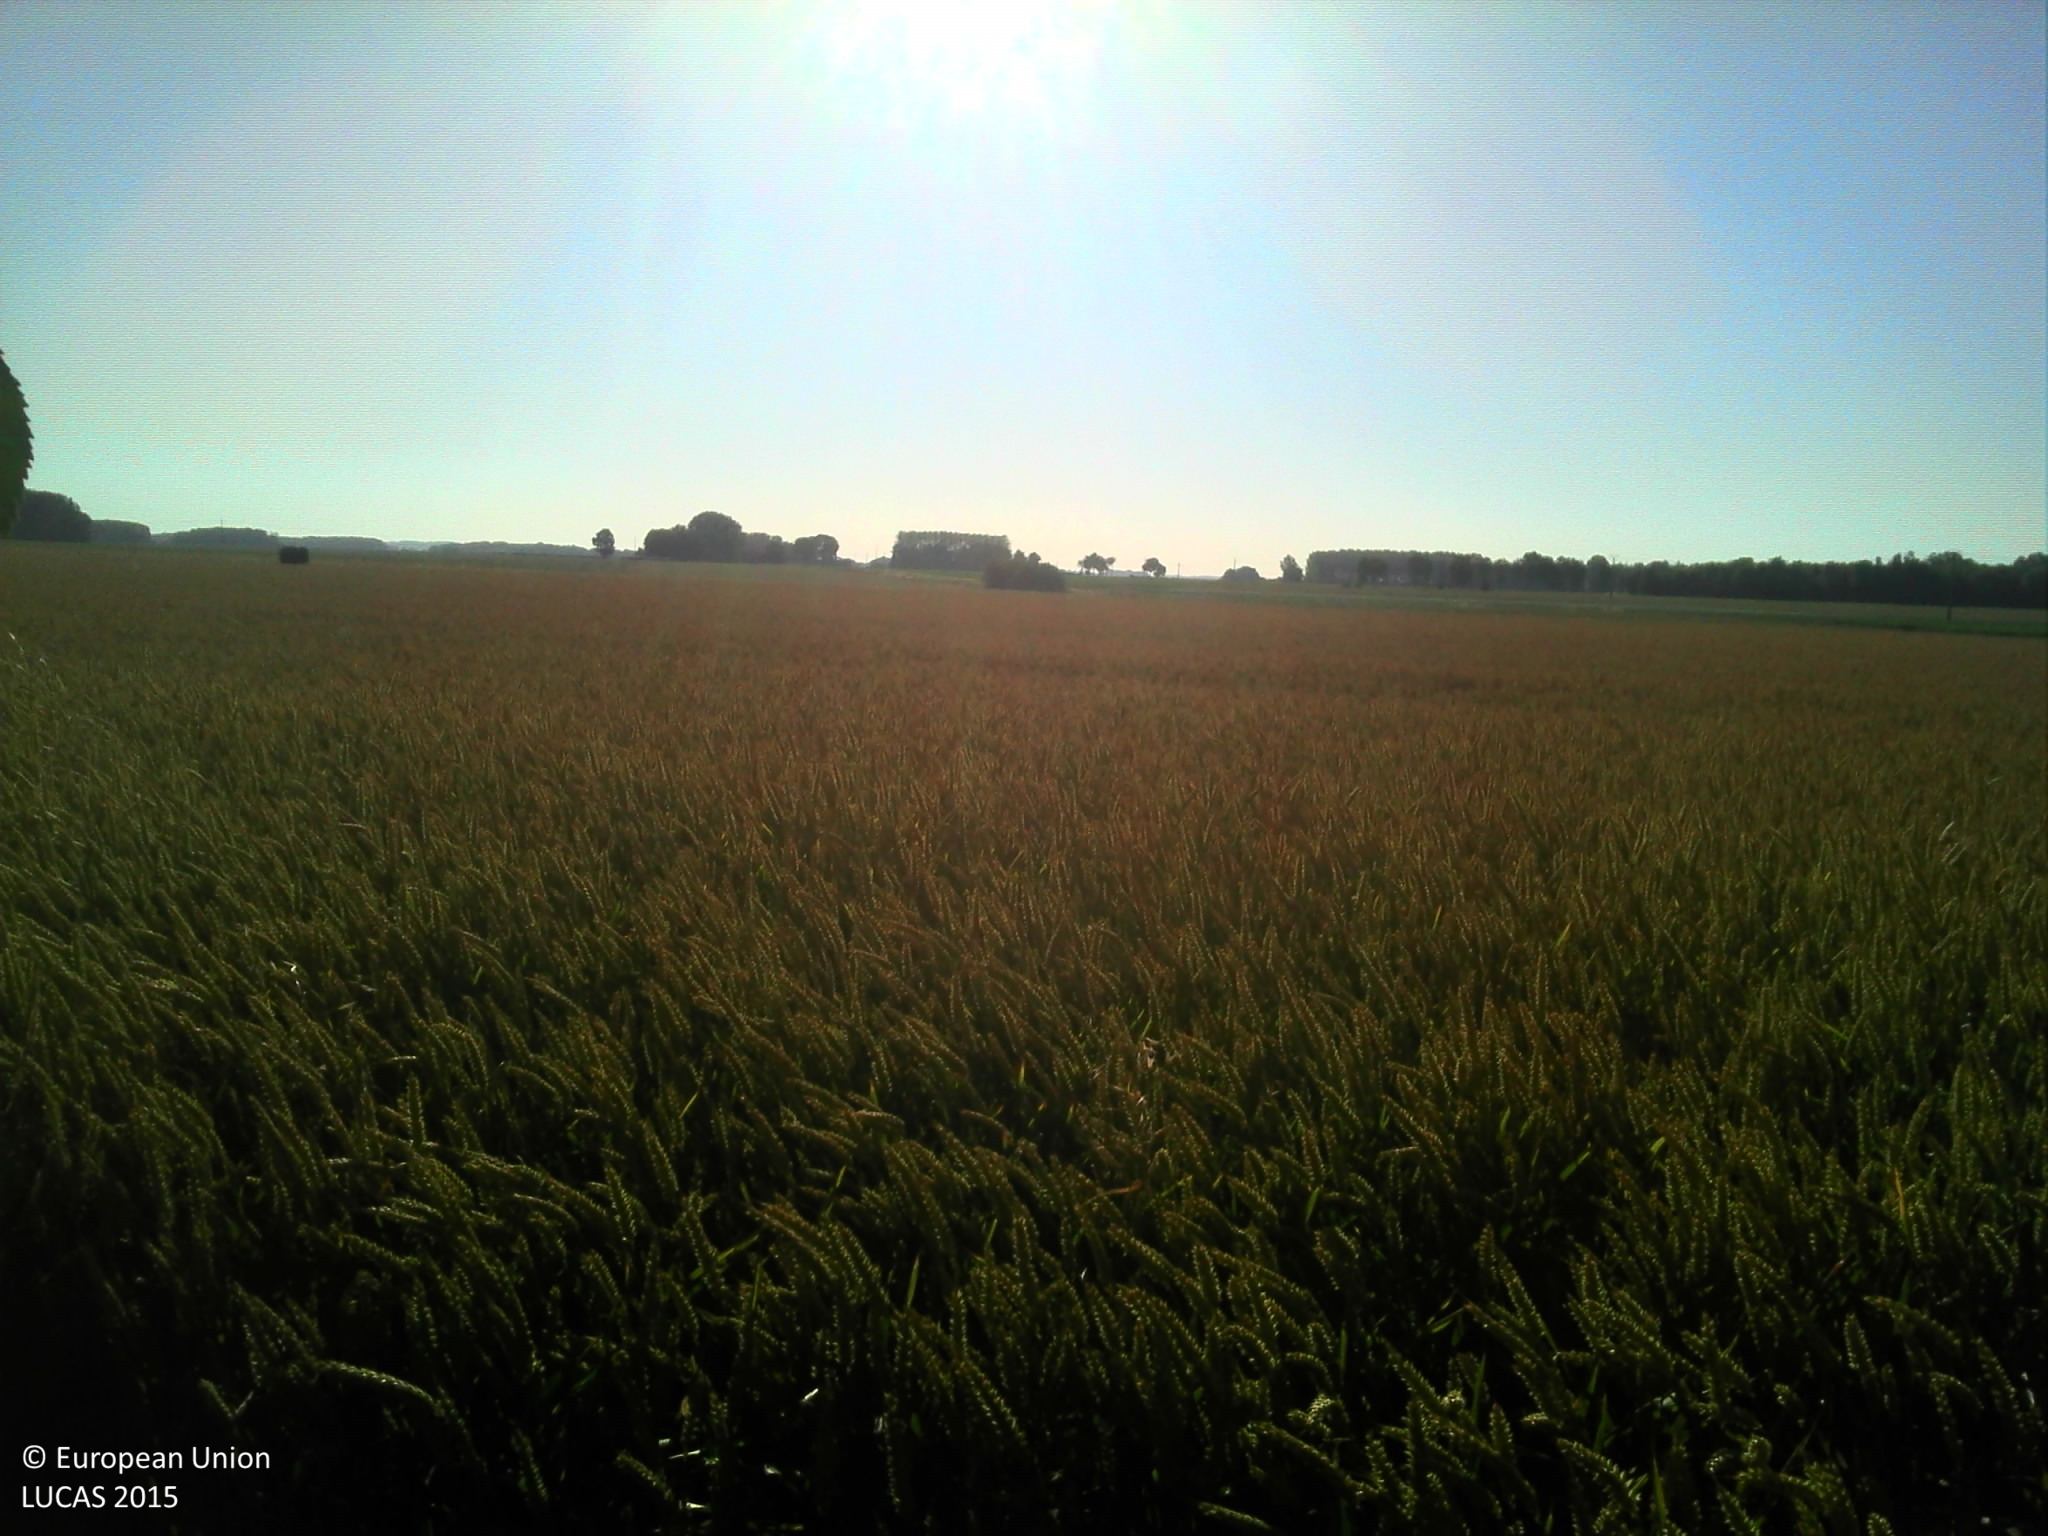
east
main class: Grassland
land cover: Grassland without tree/shrub cover
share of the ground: > 75 %
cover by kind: herbaceous plants 100 %
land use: Agriculture (excluding fallow land and kitchen gardens)
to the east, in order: Lines of trees; Common wheat; Grass margins; Tracks; Grass margins; Common wheat
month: July
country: FR
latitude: 49.9528
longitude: 1.6897
